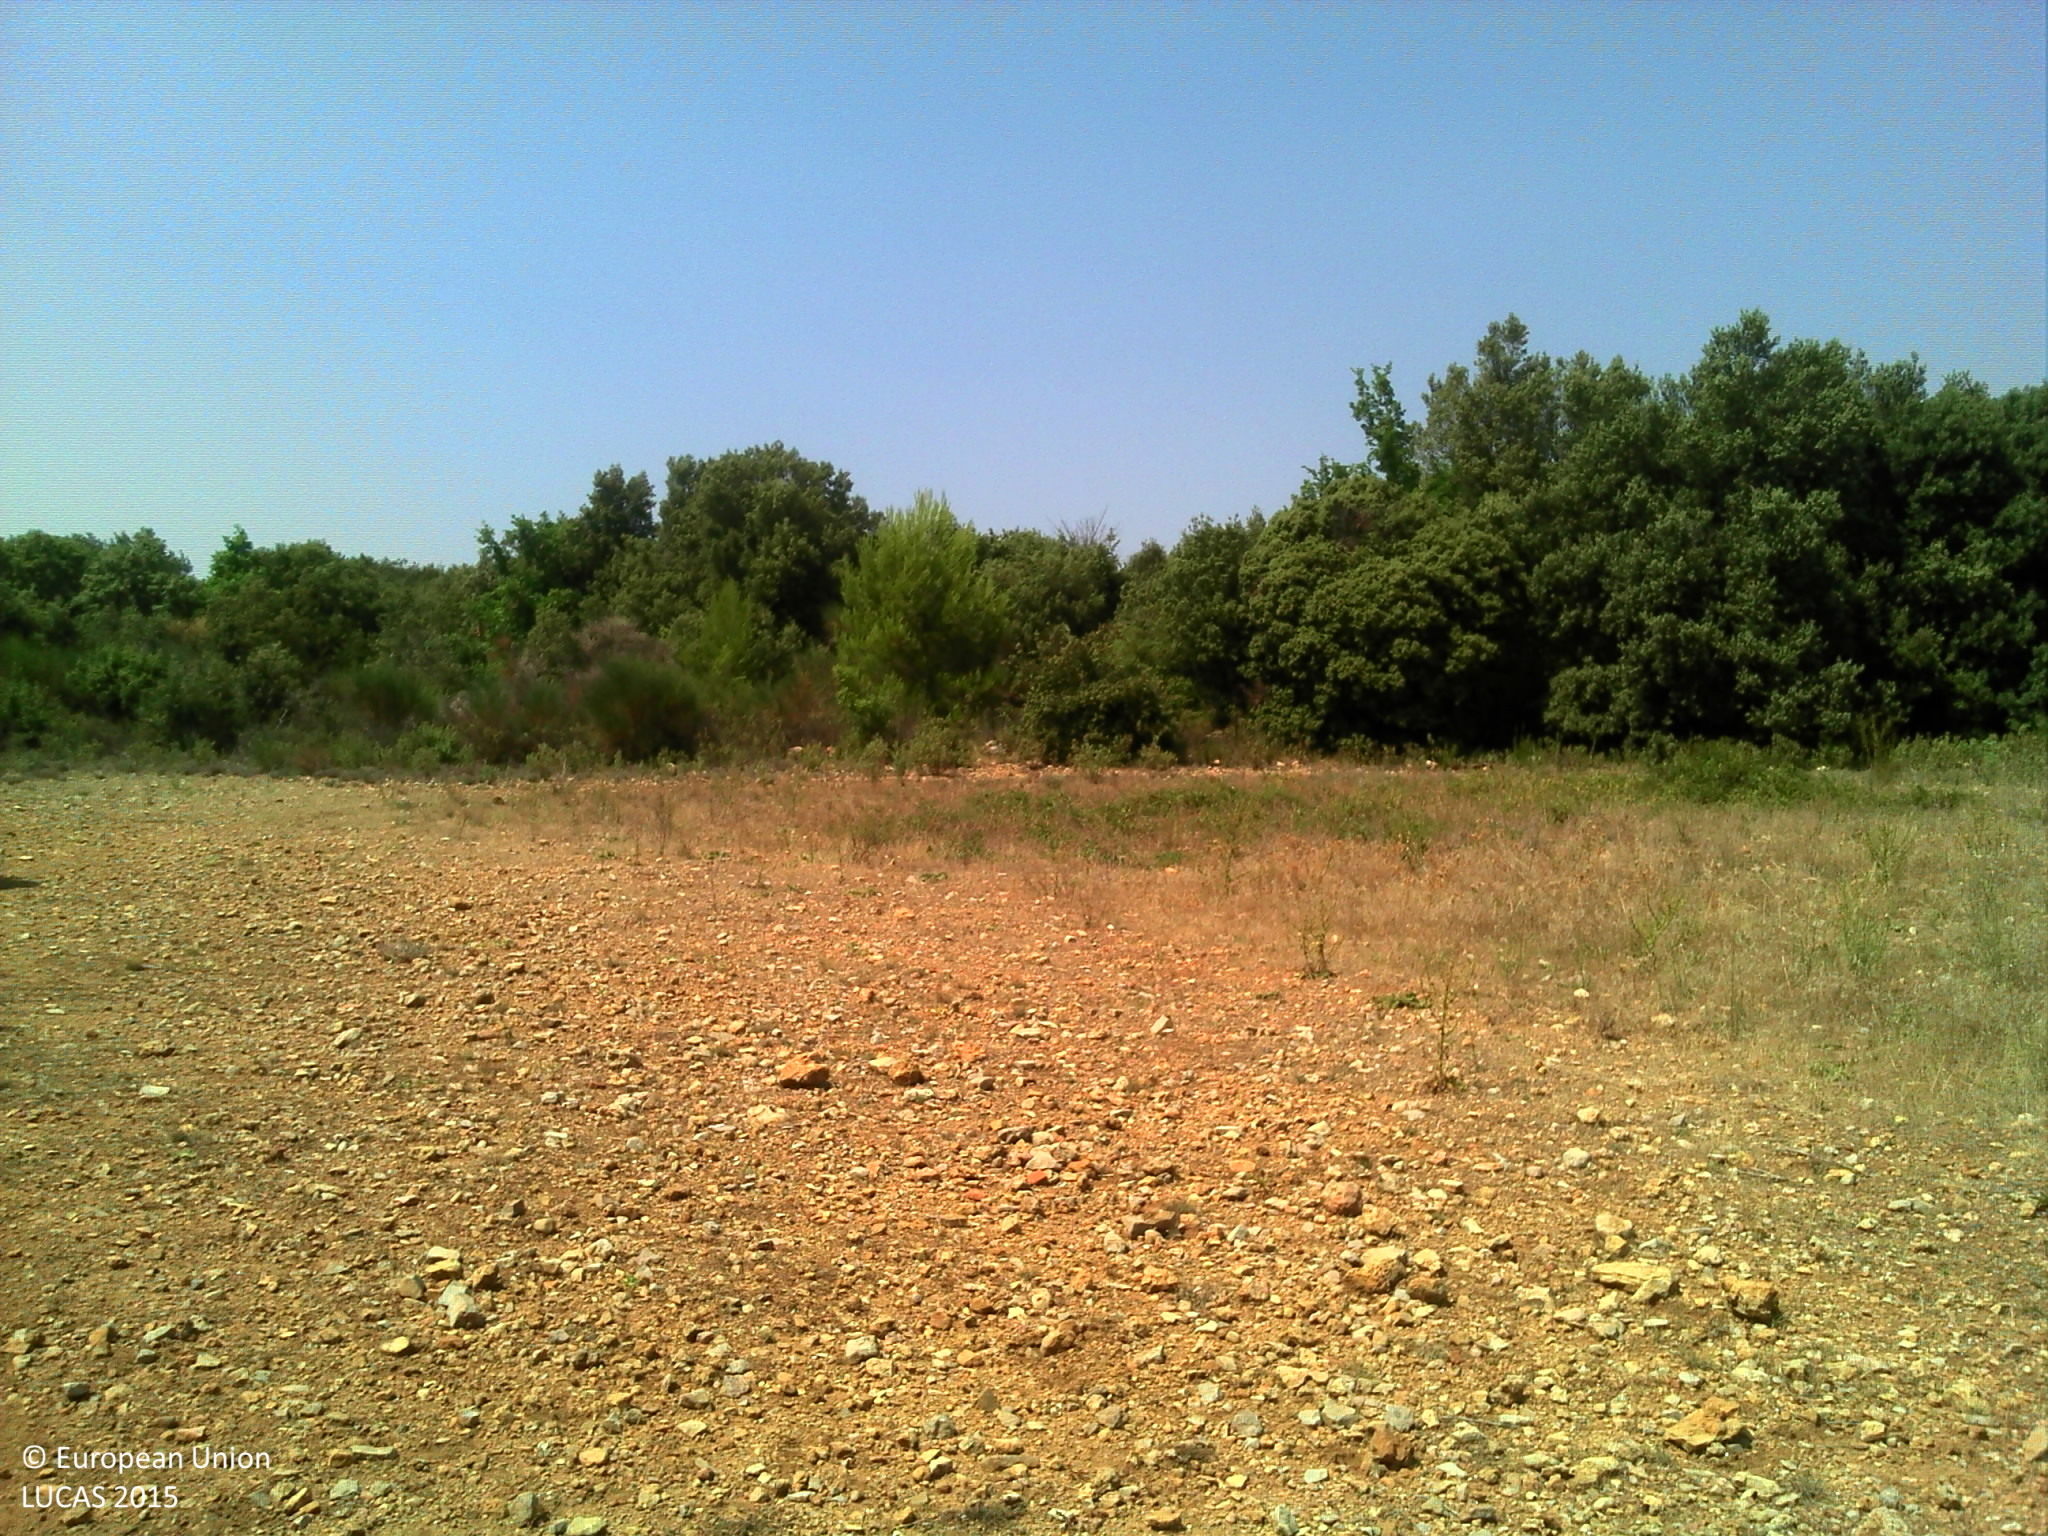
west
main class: Grassland
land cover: Spontaneously vegetated surfaces
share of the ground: > 75 %
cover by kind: herbaceous plants 75 %, unconsolidated bare surface 20 %, shrubs 5 %
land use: Semi-natural and natural areas not in use
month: August
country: FR
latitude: 43.5977
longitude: 6.2800
